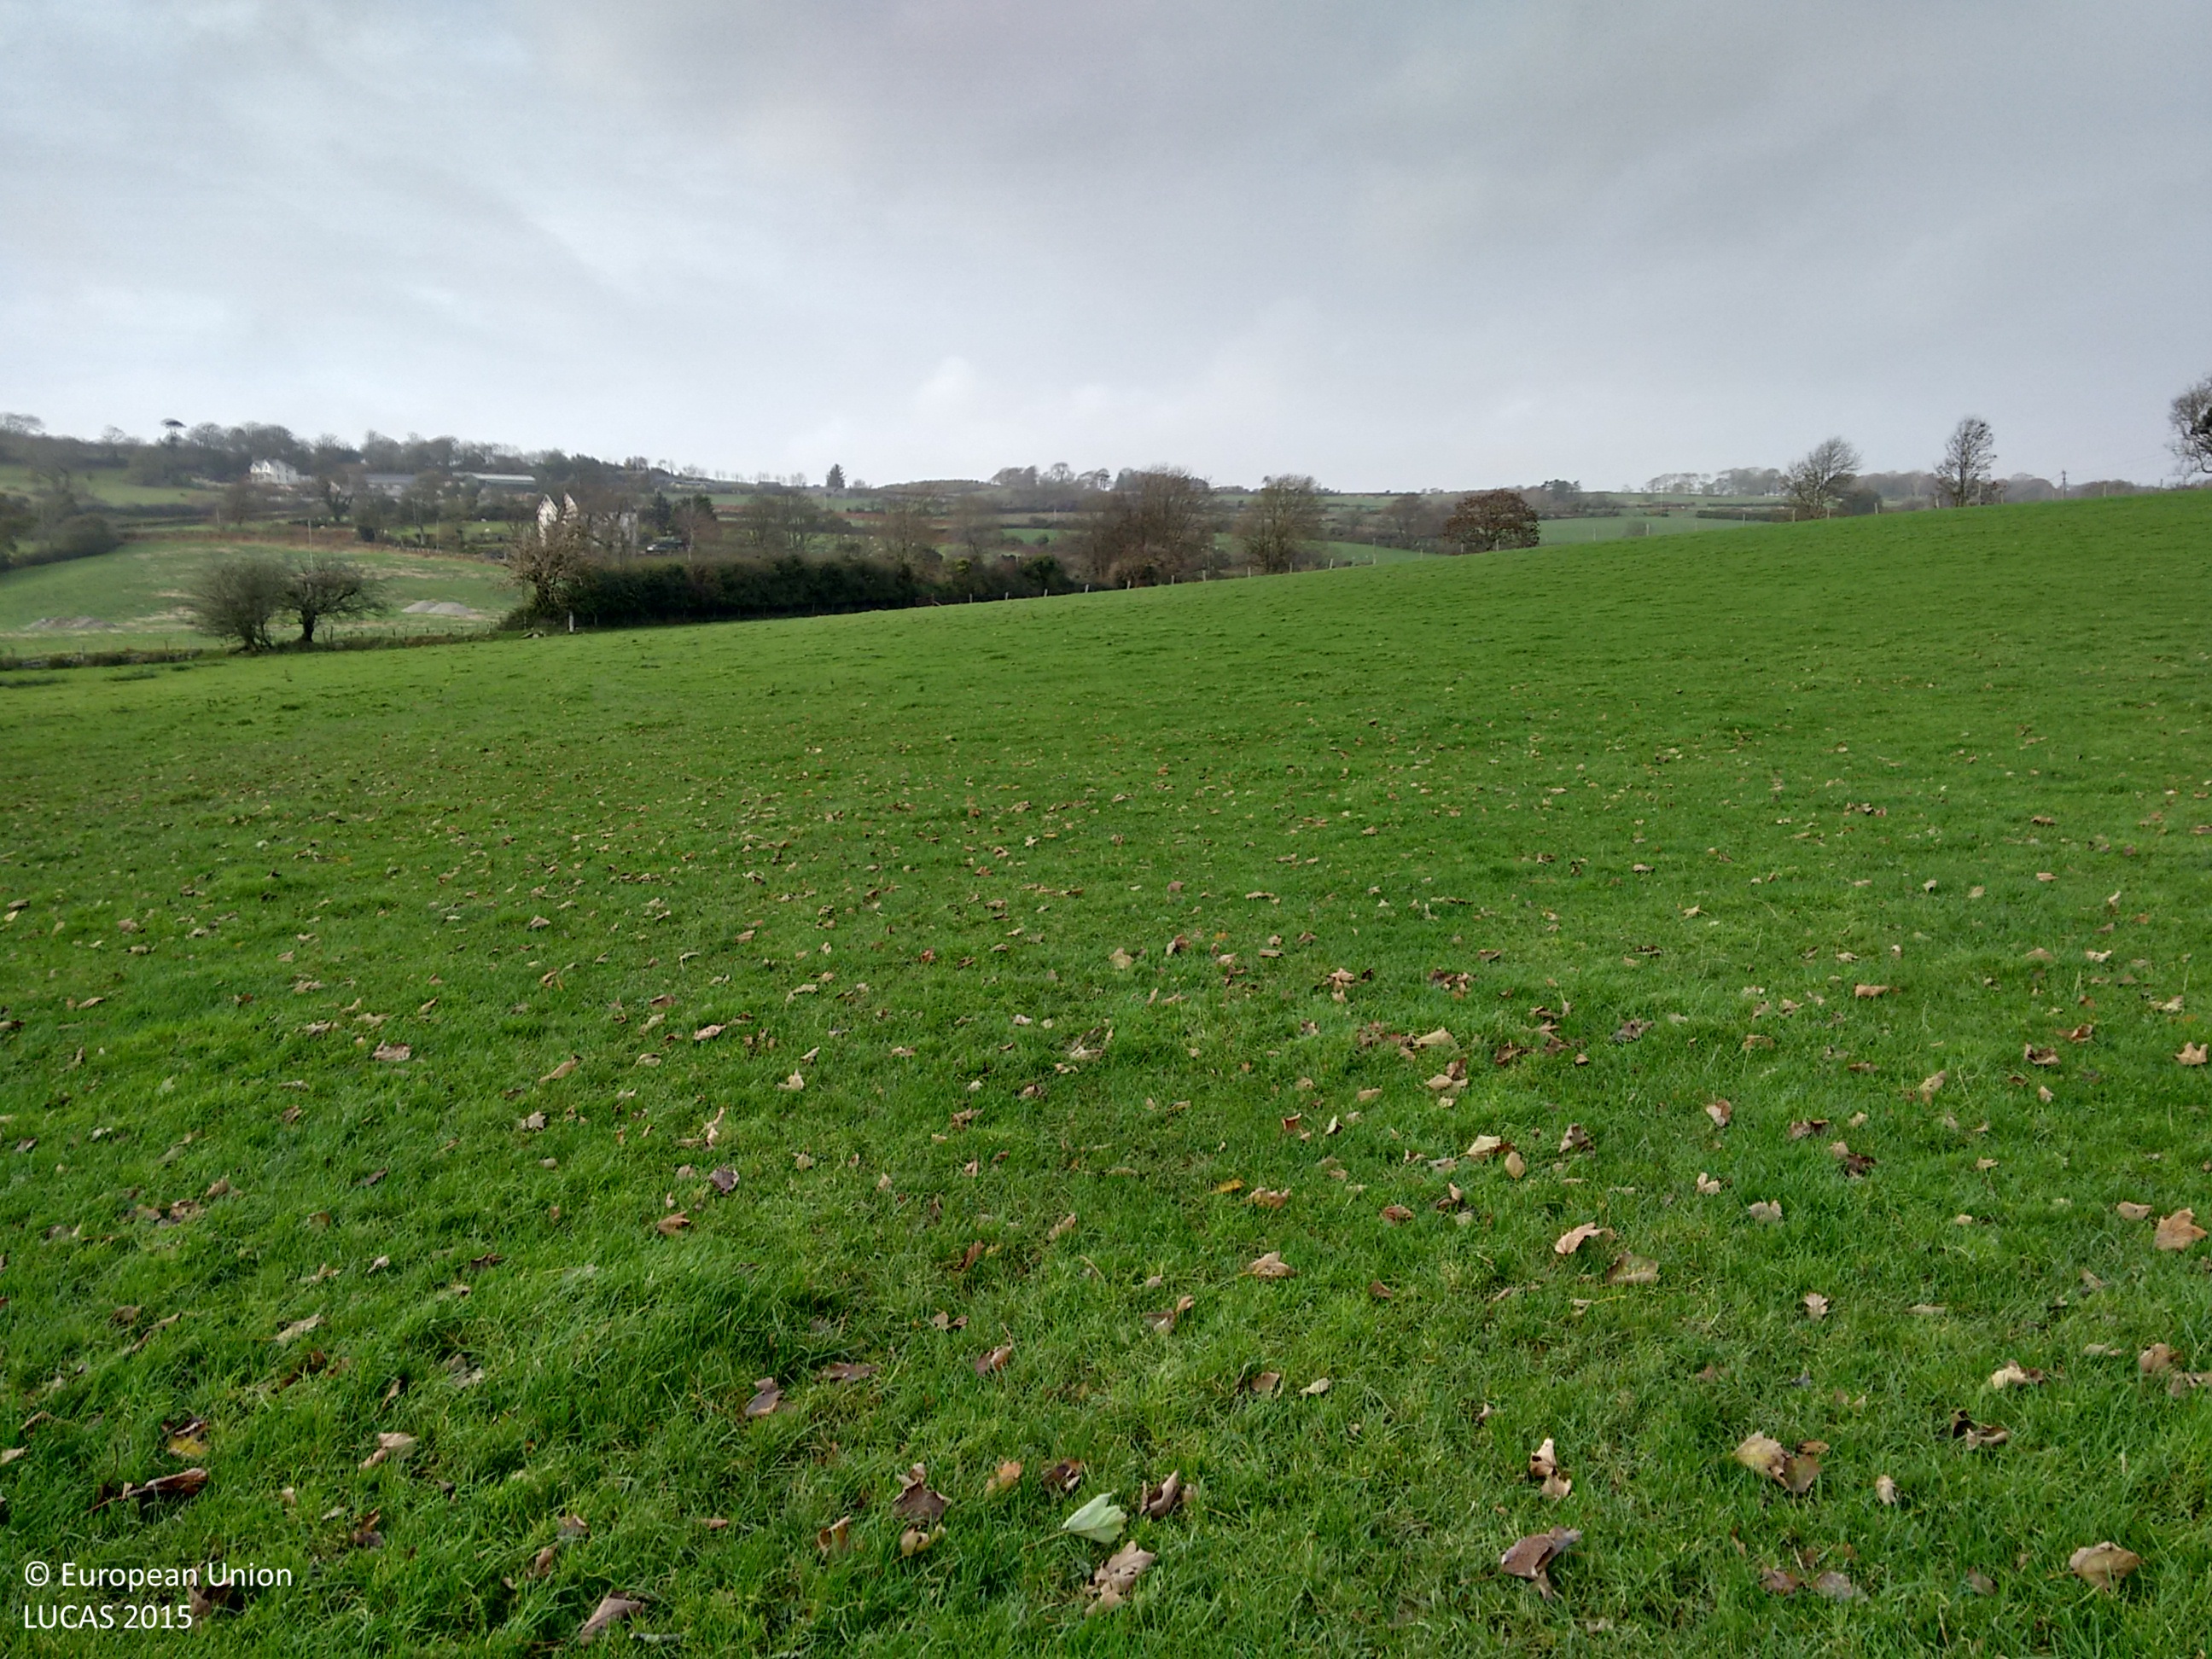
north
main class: Grassland
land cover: Grassland without tree/shrub cover
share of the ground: > 75 %
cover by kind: herbaceous plants 100 %
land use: Agriculture (excluding fallow land and kitchen gardens)
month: November
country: GB
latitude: 52.9018
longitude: -4.3898
